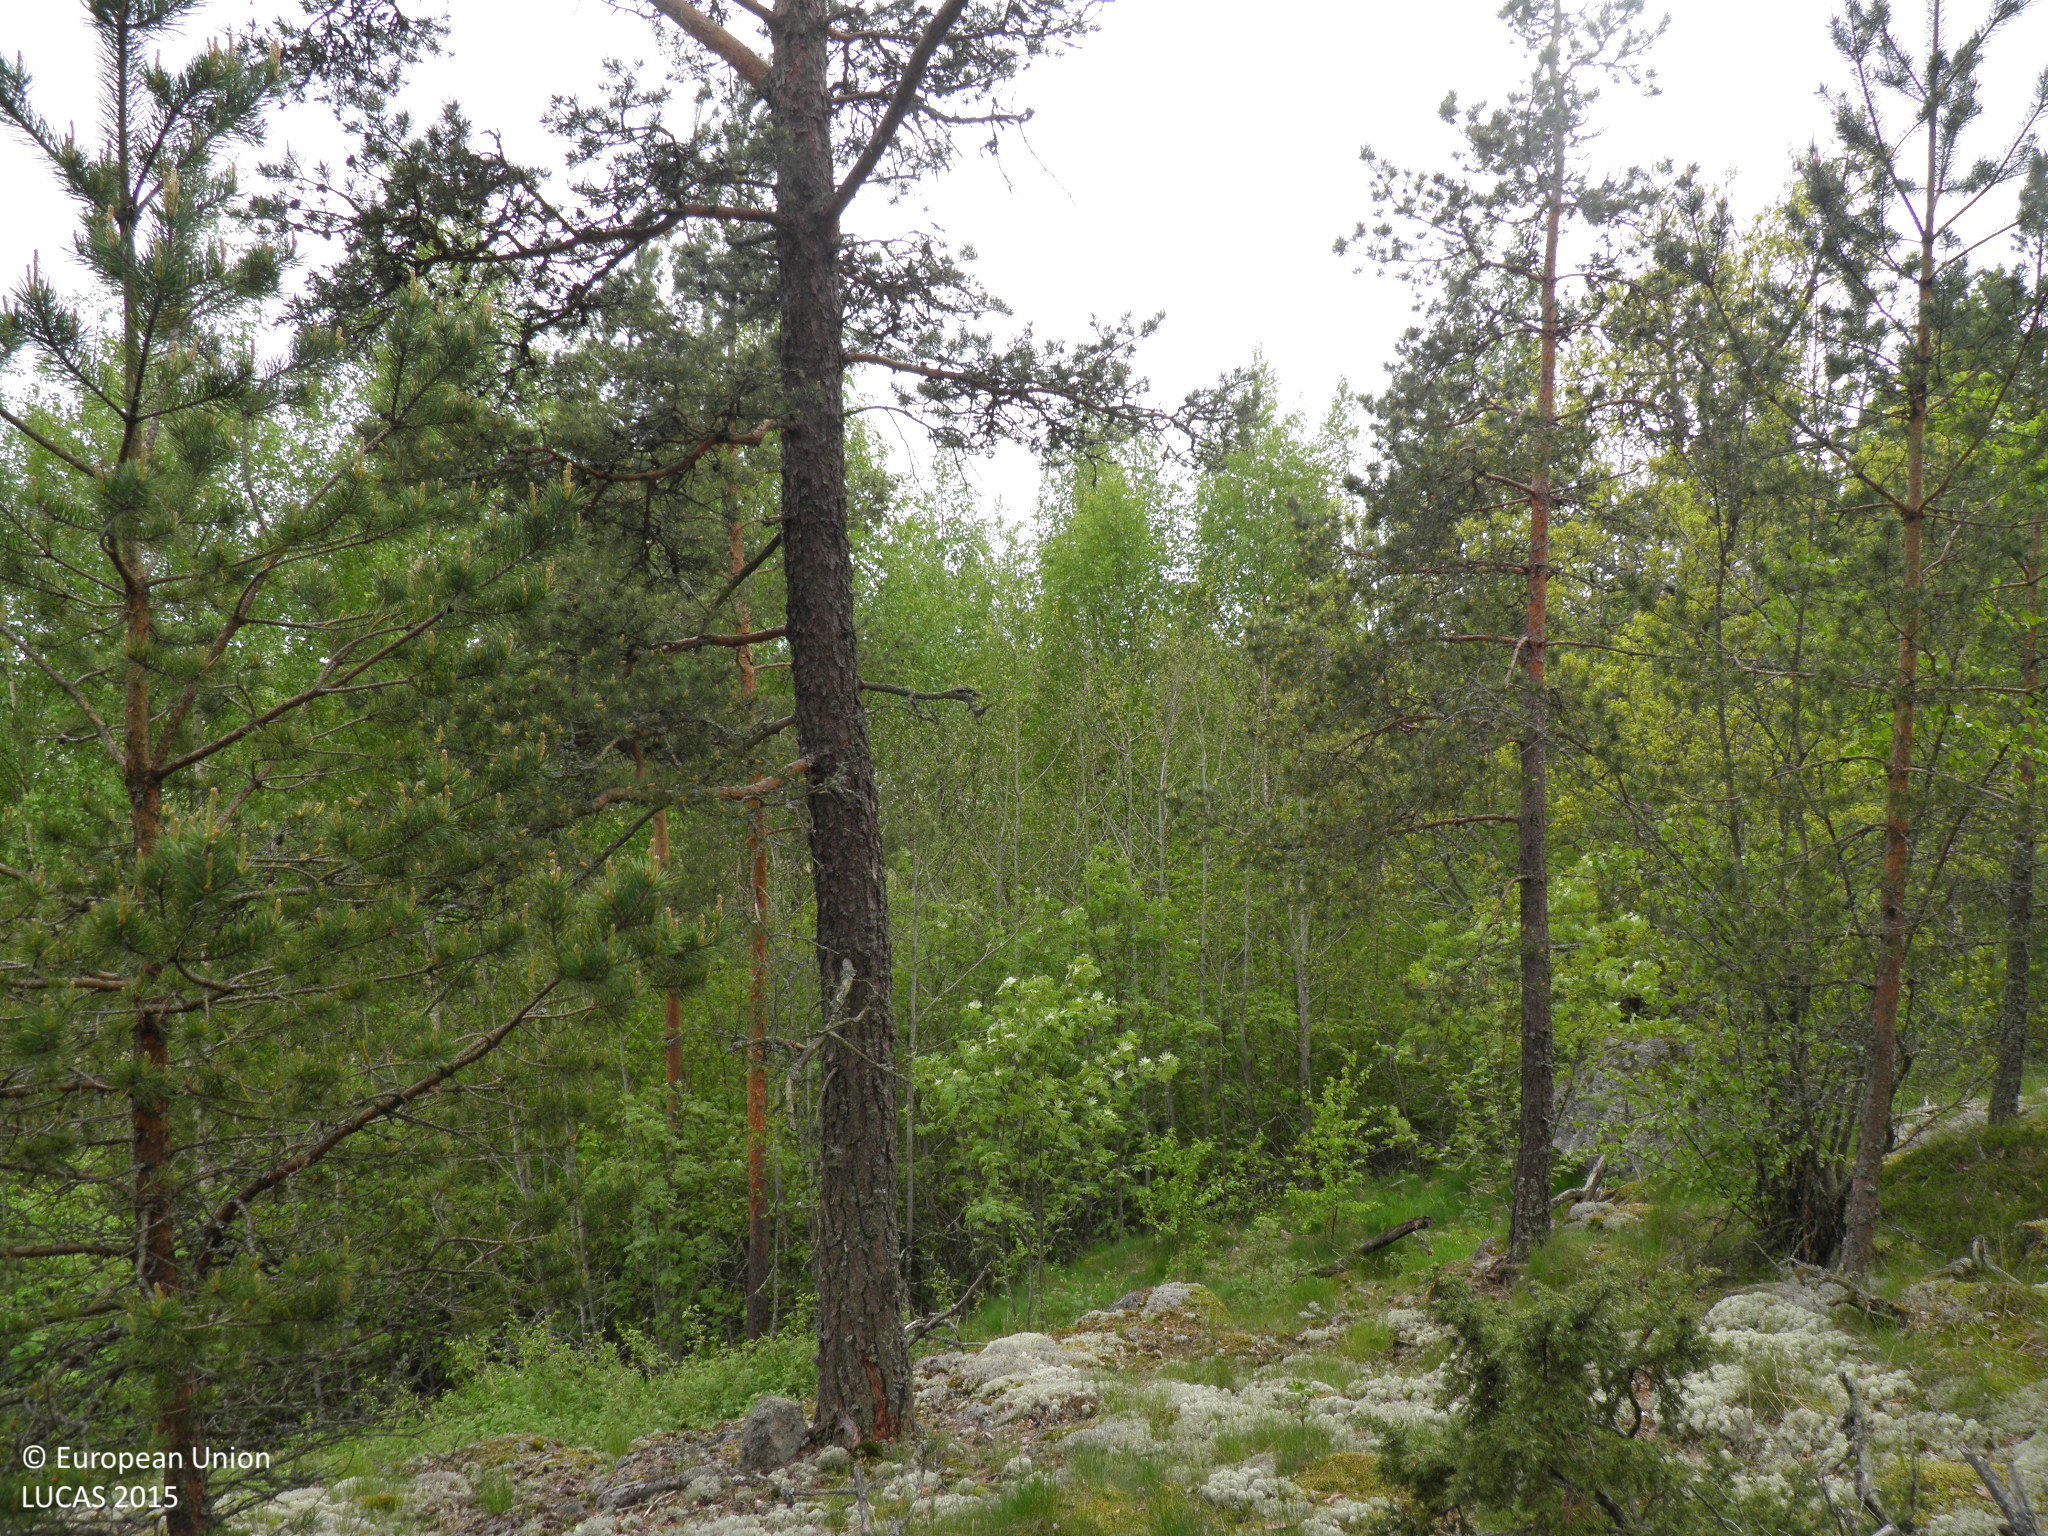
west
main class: Woodland
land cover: Pine dominated coniferous woodland
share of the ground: > 75 %
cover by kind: coniferous forest trees 80 %, broadleaved forest trees 10 %, shrubs 5 %, herbaceous plants 5 %
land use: Forestry
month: June
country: FI
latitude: 60.5108
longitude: 22.3609
